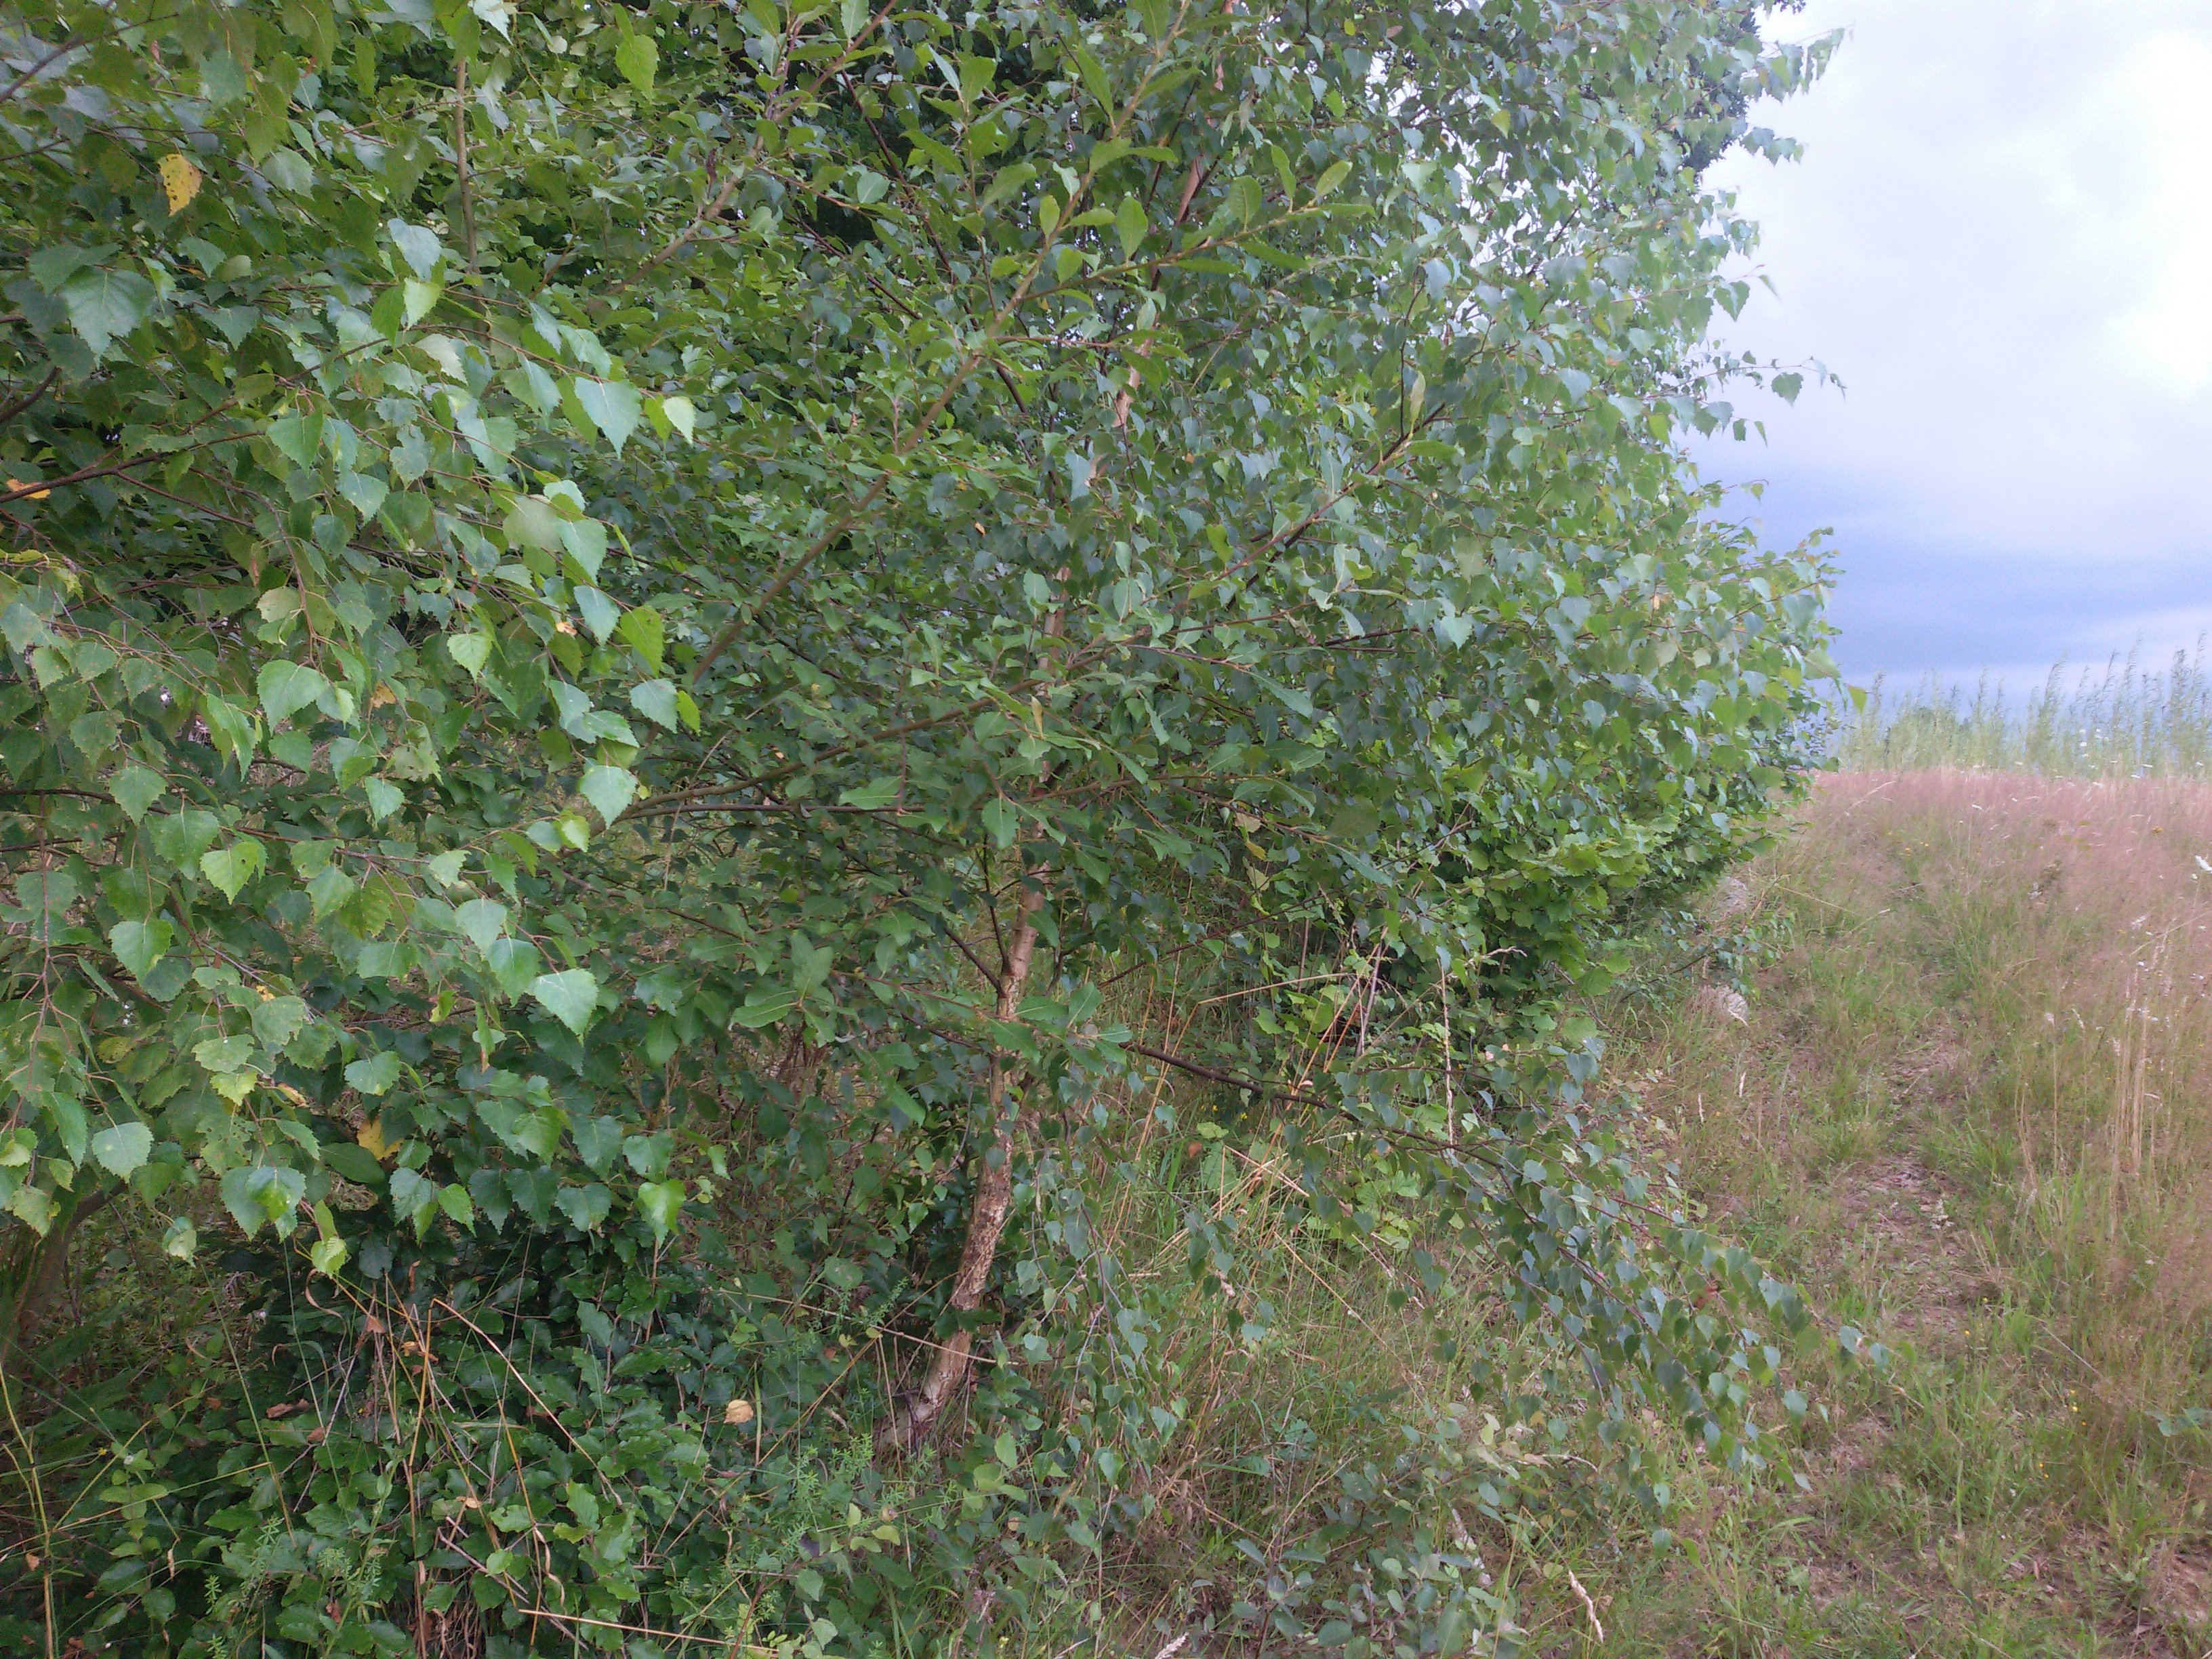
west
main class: Woodland
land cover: Broadleaved woodland
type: mesophytic deciduous forest
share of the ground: 50 - 75 %
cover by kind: broadleaved forest trees 60 %, shrubs 30 %, herbaceous plants 10 %
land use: Semi-natural and natural areas not in use
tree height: > 5 m
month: July
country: PL
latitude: 53.5535
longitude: 15.7550
